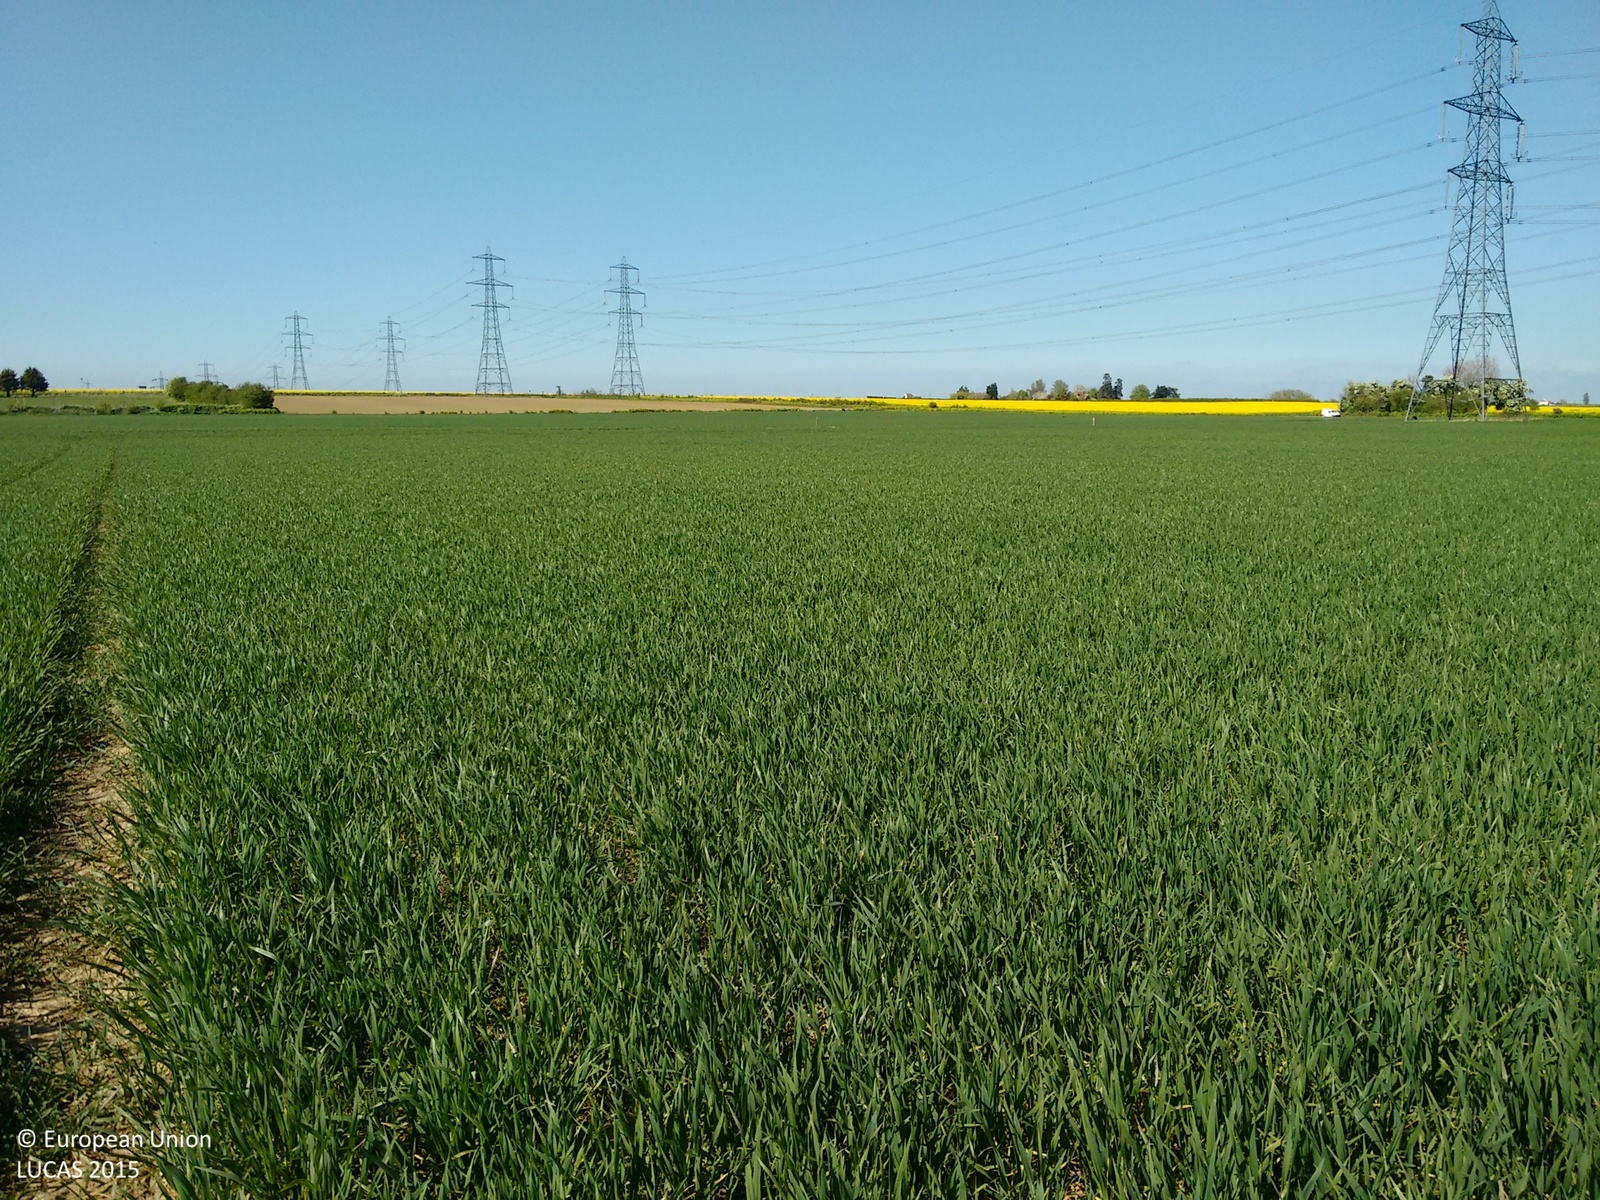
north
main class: Cropland
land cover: Common wheat
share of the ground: > 75 %
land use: Agriculture (excluding fallow land and kitchen gardens)
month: April
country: GB
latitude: 51.4230
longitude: 0.5820
